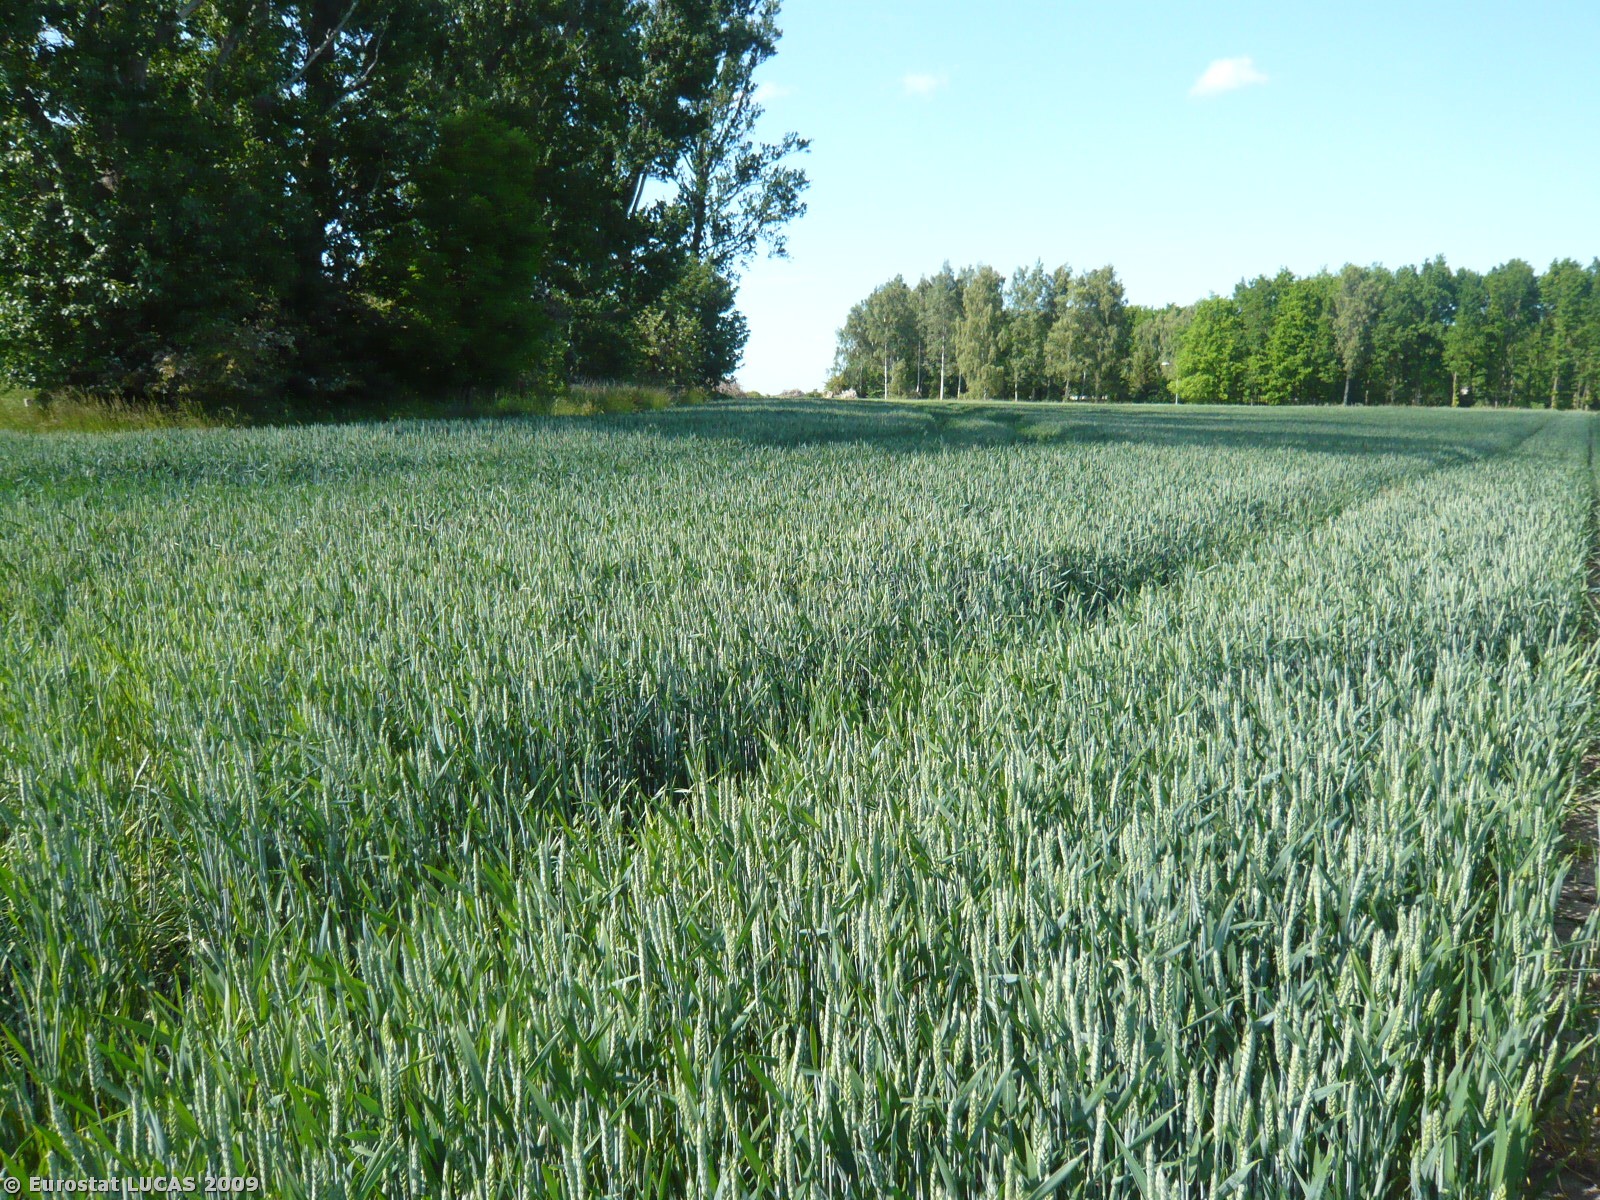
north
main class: Cropland
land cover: Common wheat
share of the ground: > 75 %
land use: Agriculture (excluding fallow land and kitchen gardens)
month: June
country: DK
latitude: 55.3006
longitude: 11.2748
